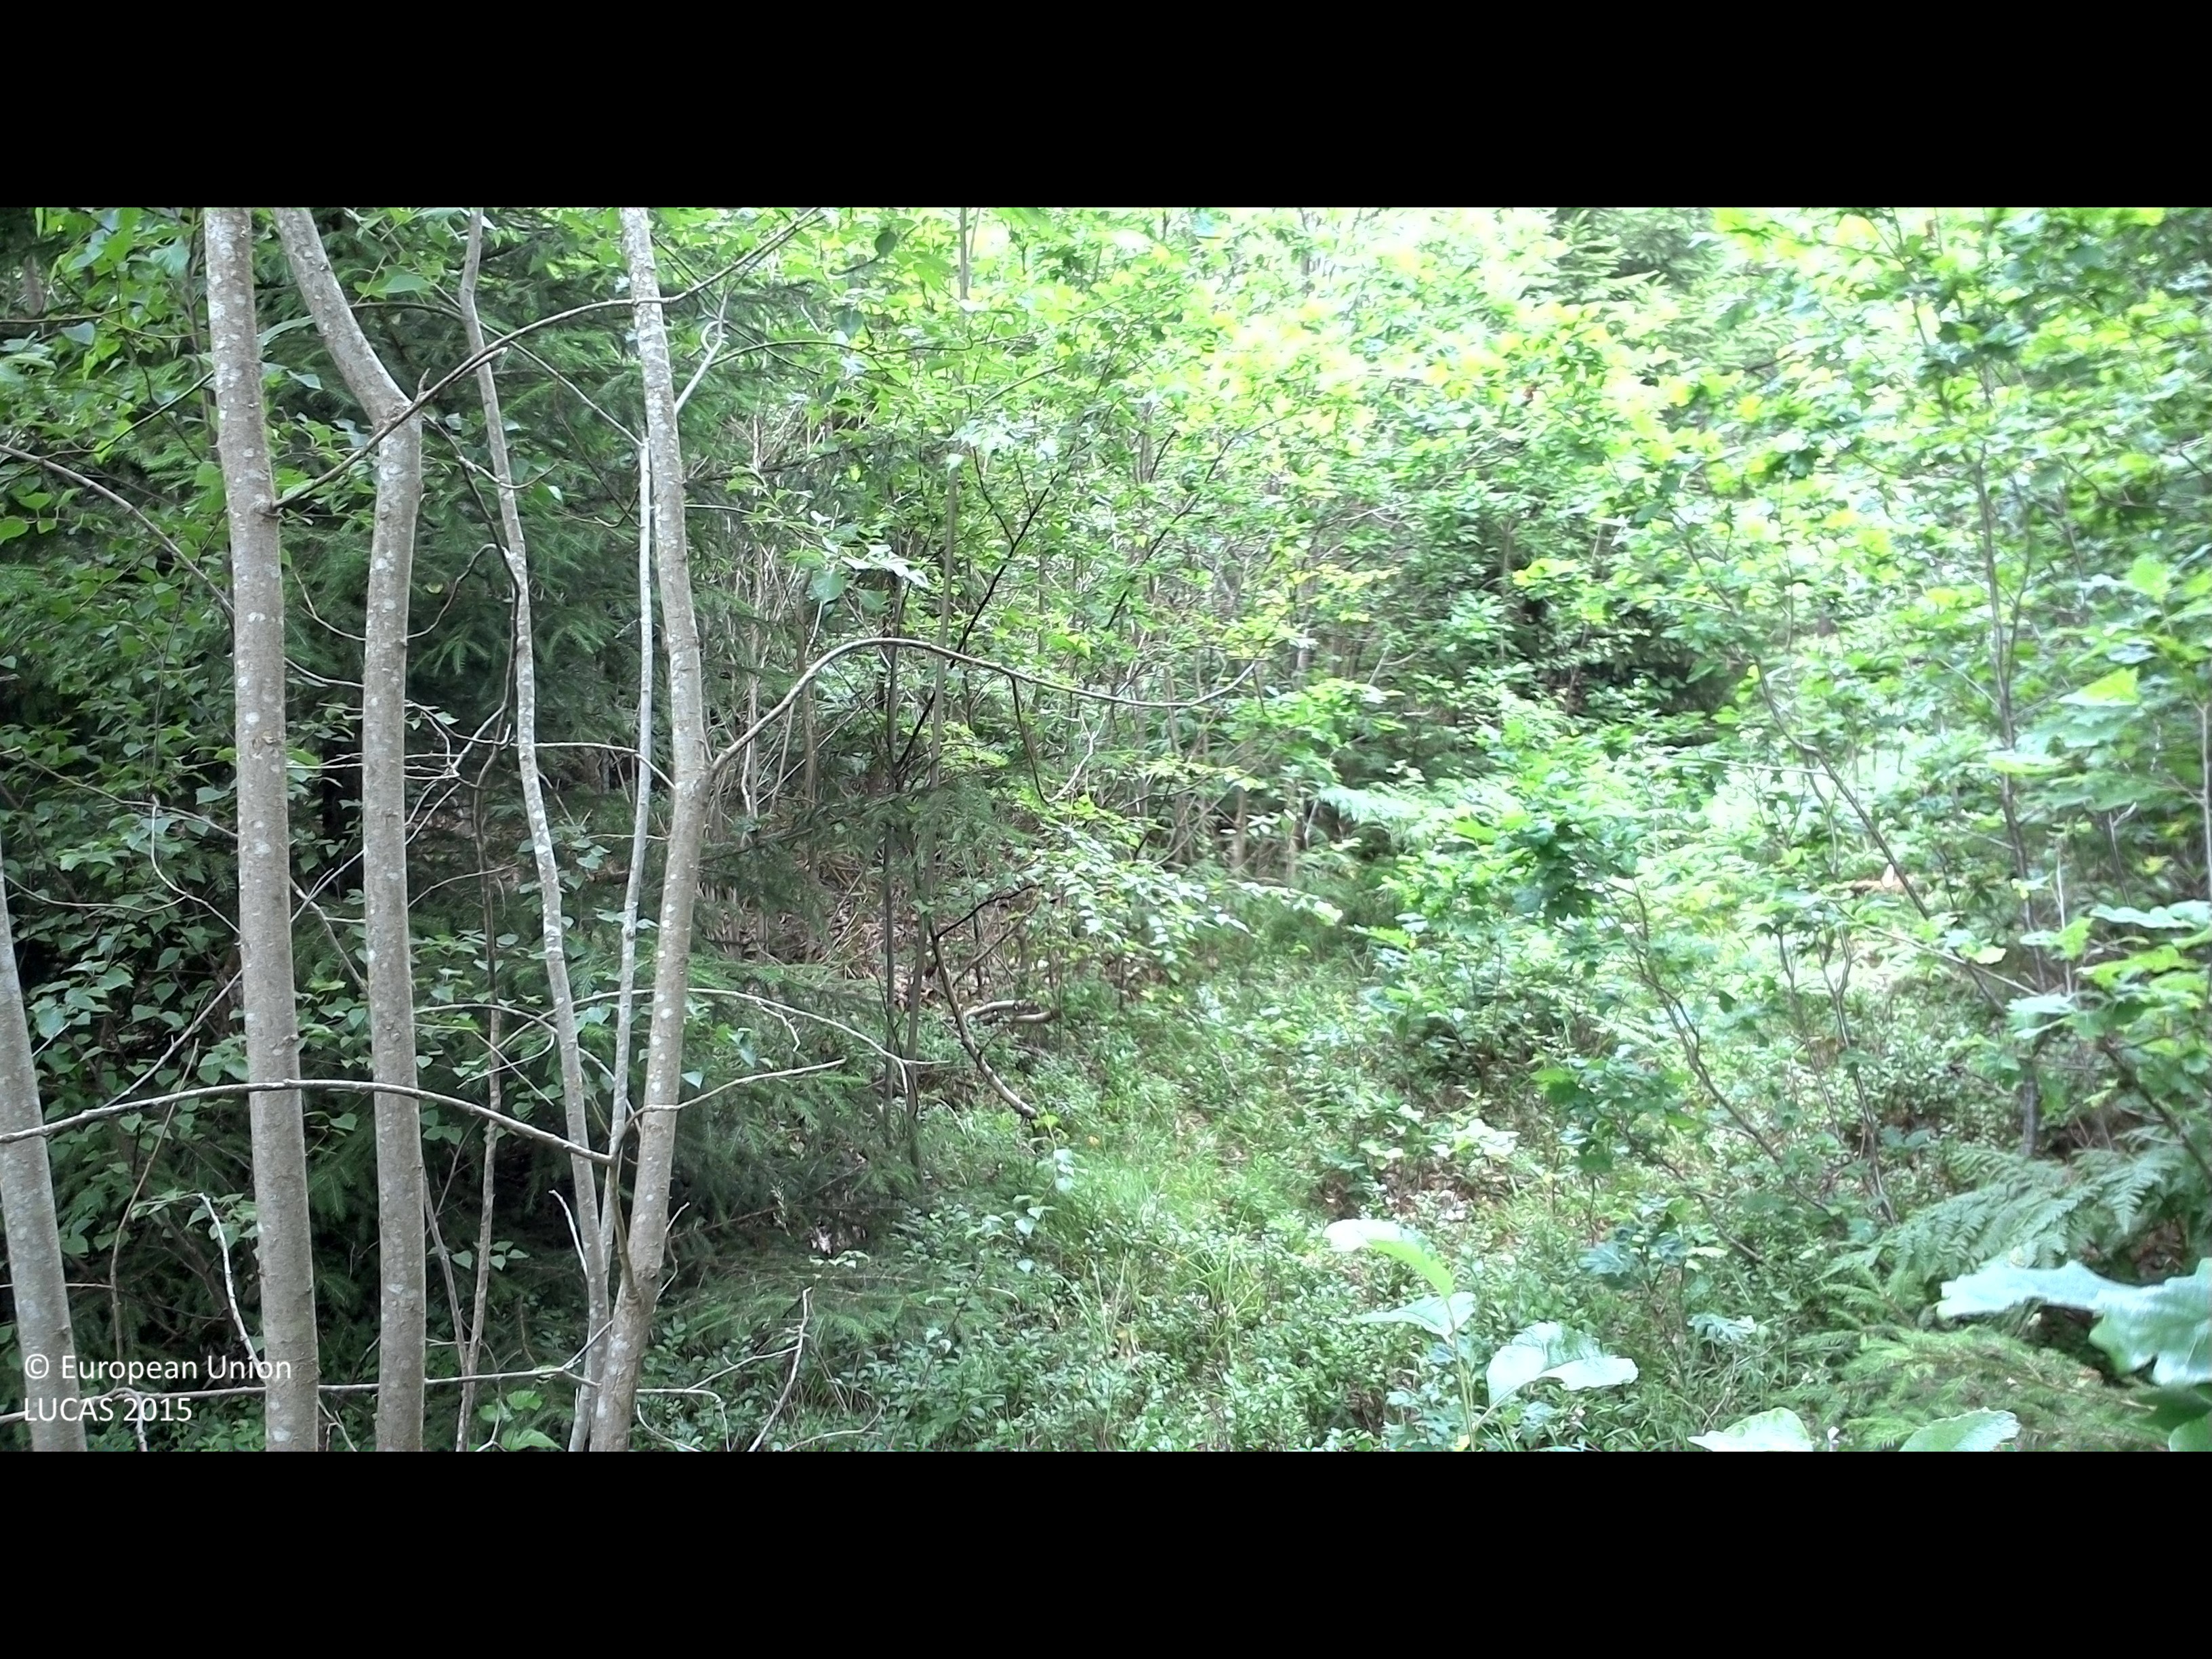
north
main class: Woodland
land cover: Broadleaved woodland
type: acidophilous oak and oak-birch forest
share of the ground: > 75 %
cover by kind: broadleaved forest trees 75 %, herbaceous plants 15 %, coniferous forest trees 5 %, shrubs 5 %
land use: Forestry
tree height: > 5 m
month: July
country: SE
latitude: 56.3782
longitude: 15.4563
